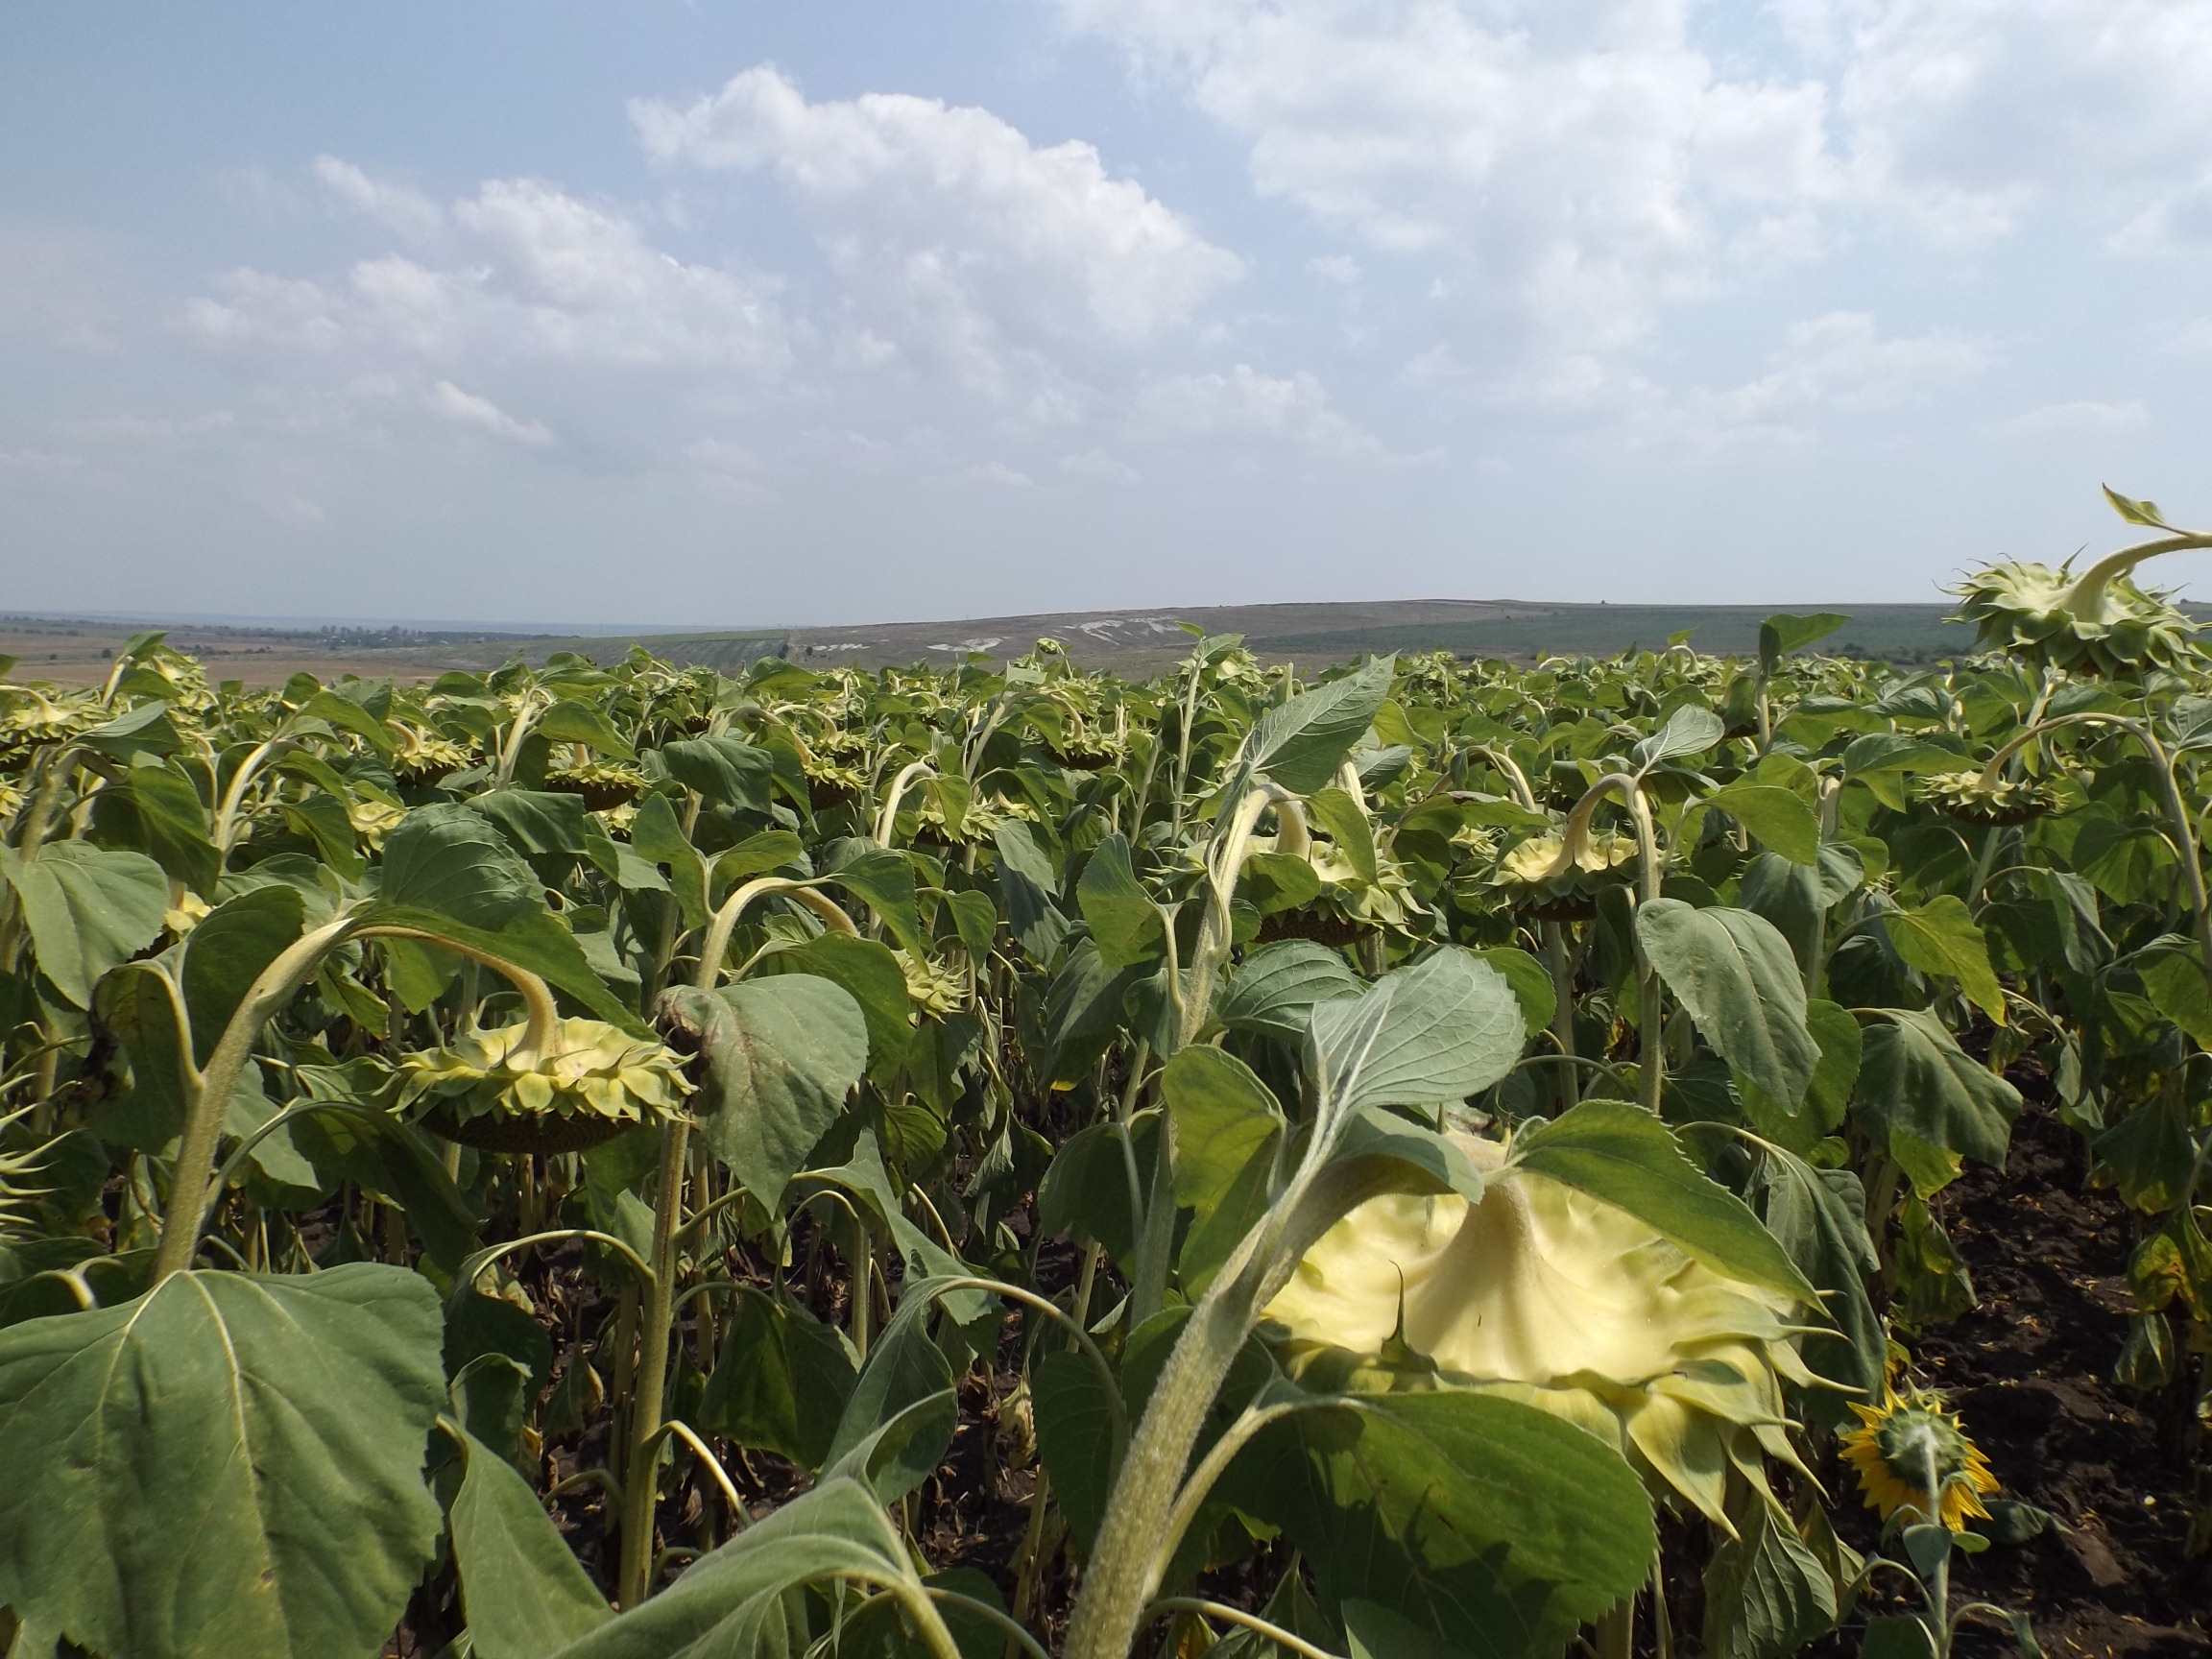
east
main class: Cropland
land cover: Sunflower
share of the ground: > 75 %
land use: Agriculture (excluding fallow land and kitchen gardens)
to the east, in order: Sunflower
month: July
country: BG
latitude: 43.4623
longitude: 27.4705
